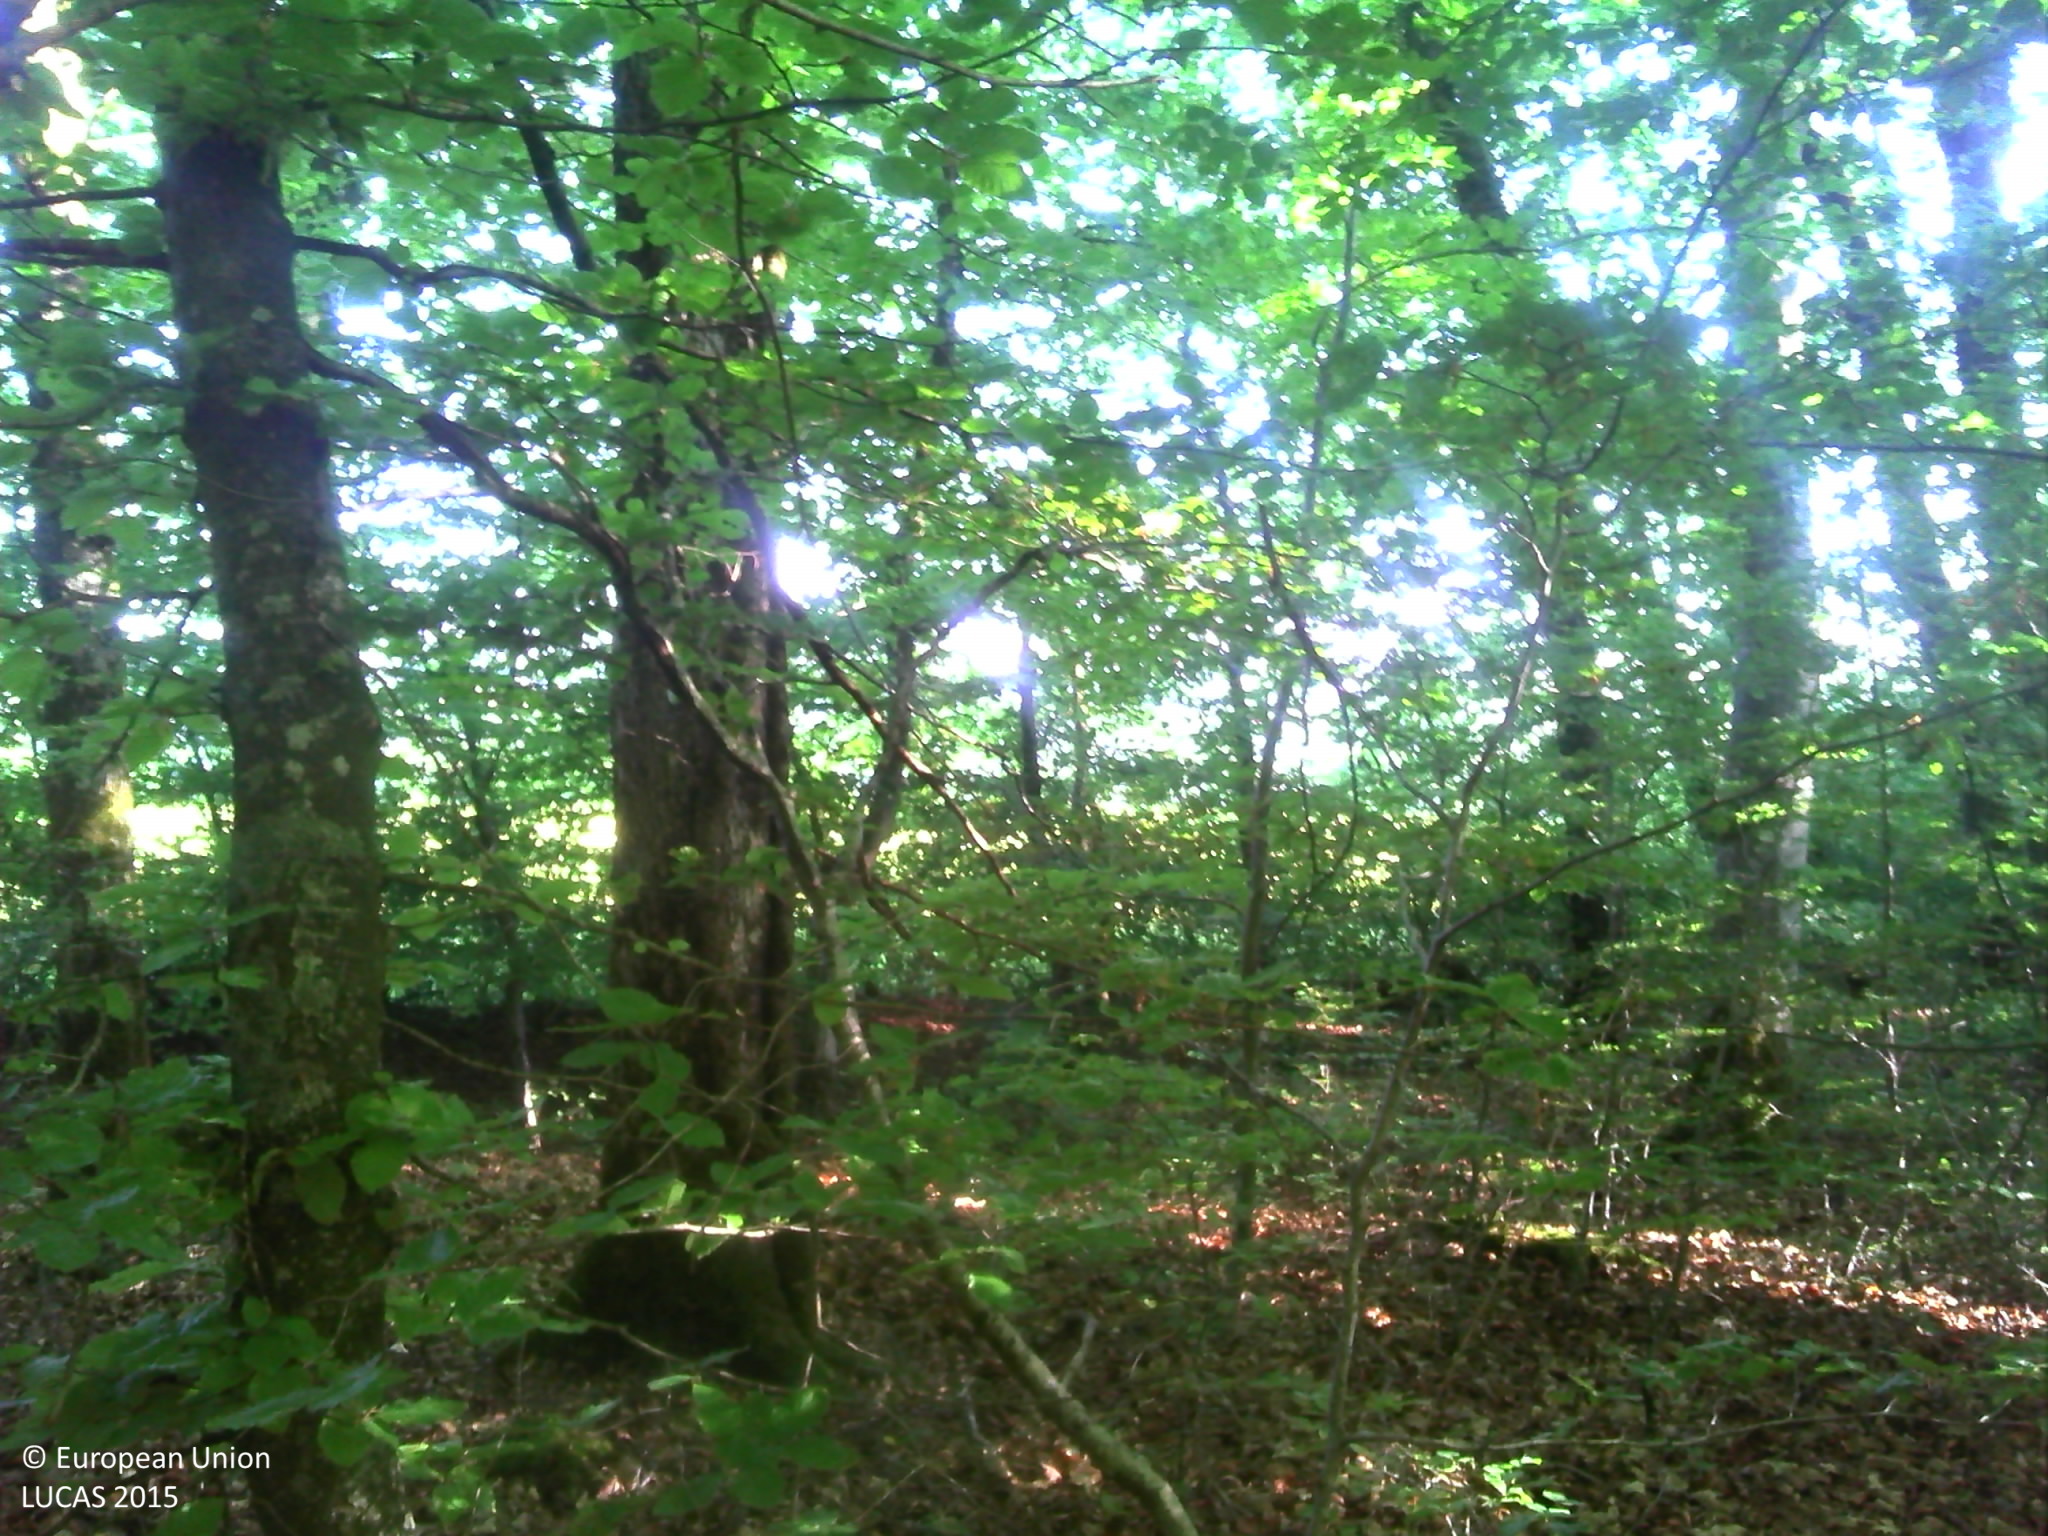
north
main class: Woodland
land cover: Broadleaved woodland
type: acidophilous oak and oak-birch forest
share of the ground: > 75 %
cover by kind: broadleaved forest trees 95 %, herbaceous plants 5 %
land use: Forestry
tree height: > 5 m
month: May
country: LU
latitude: 49.8178
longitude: 6.2886
